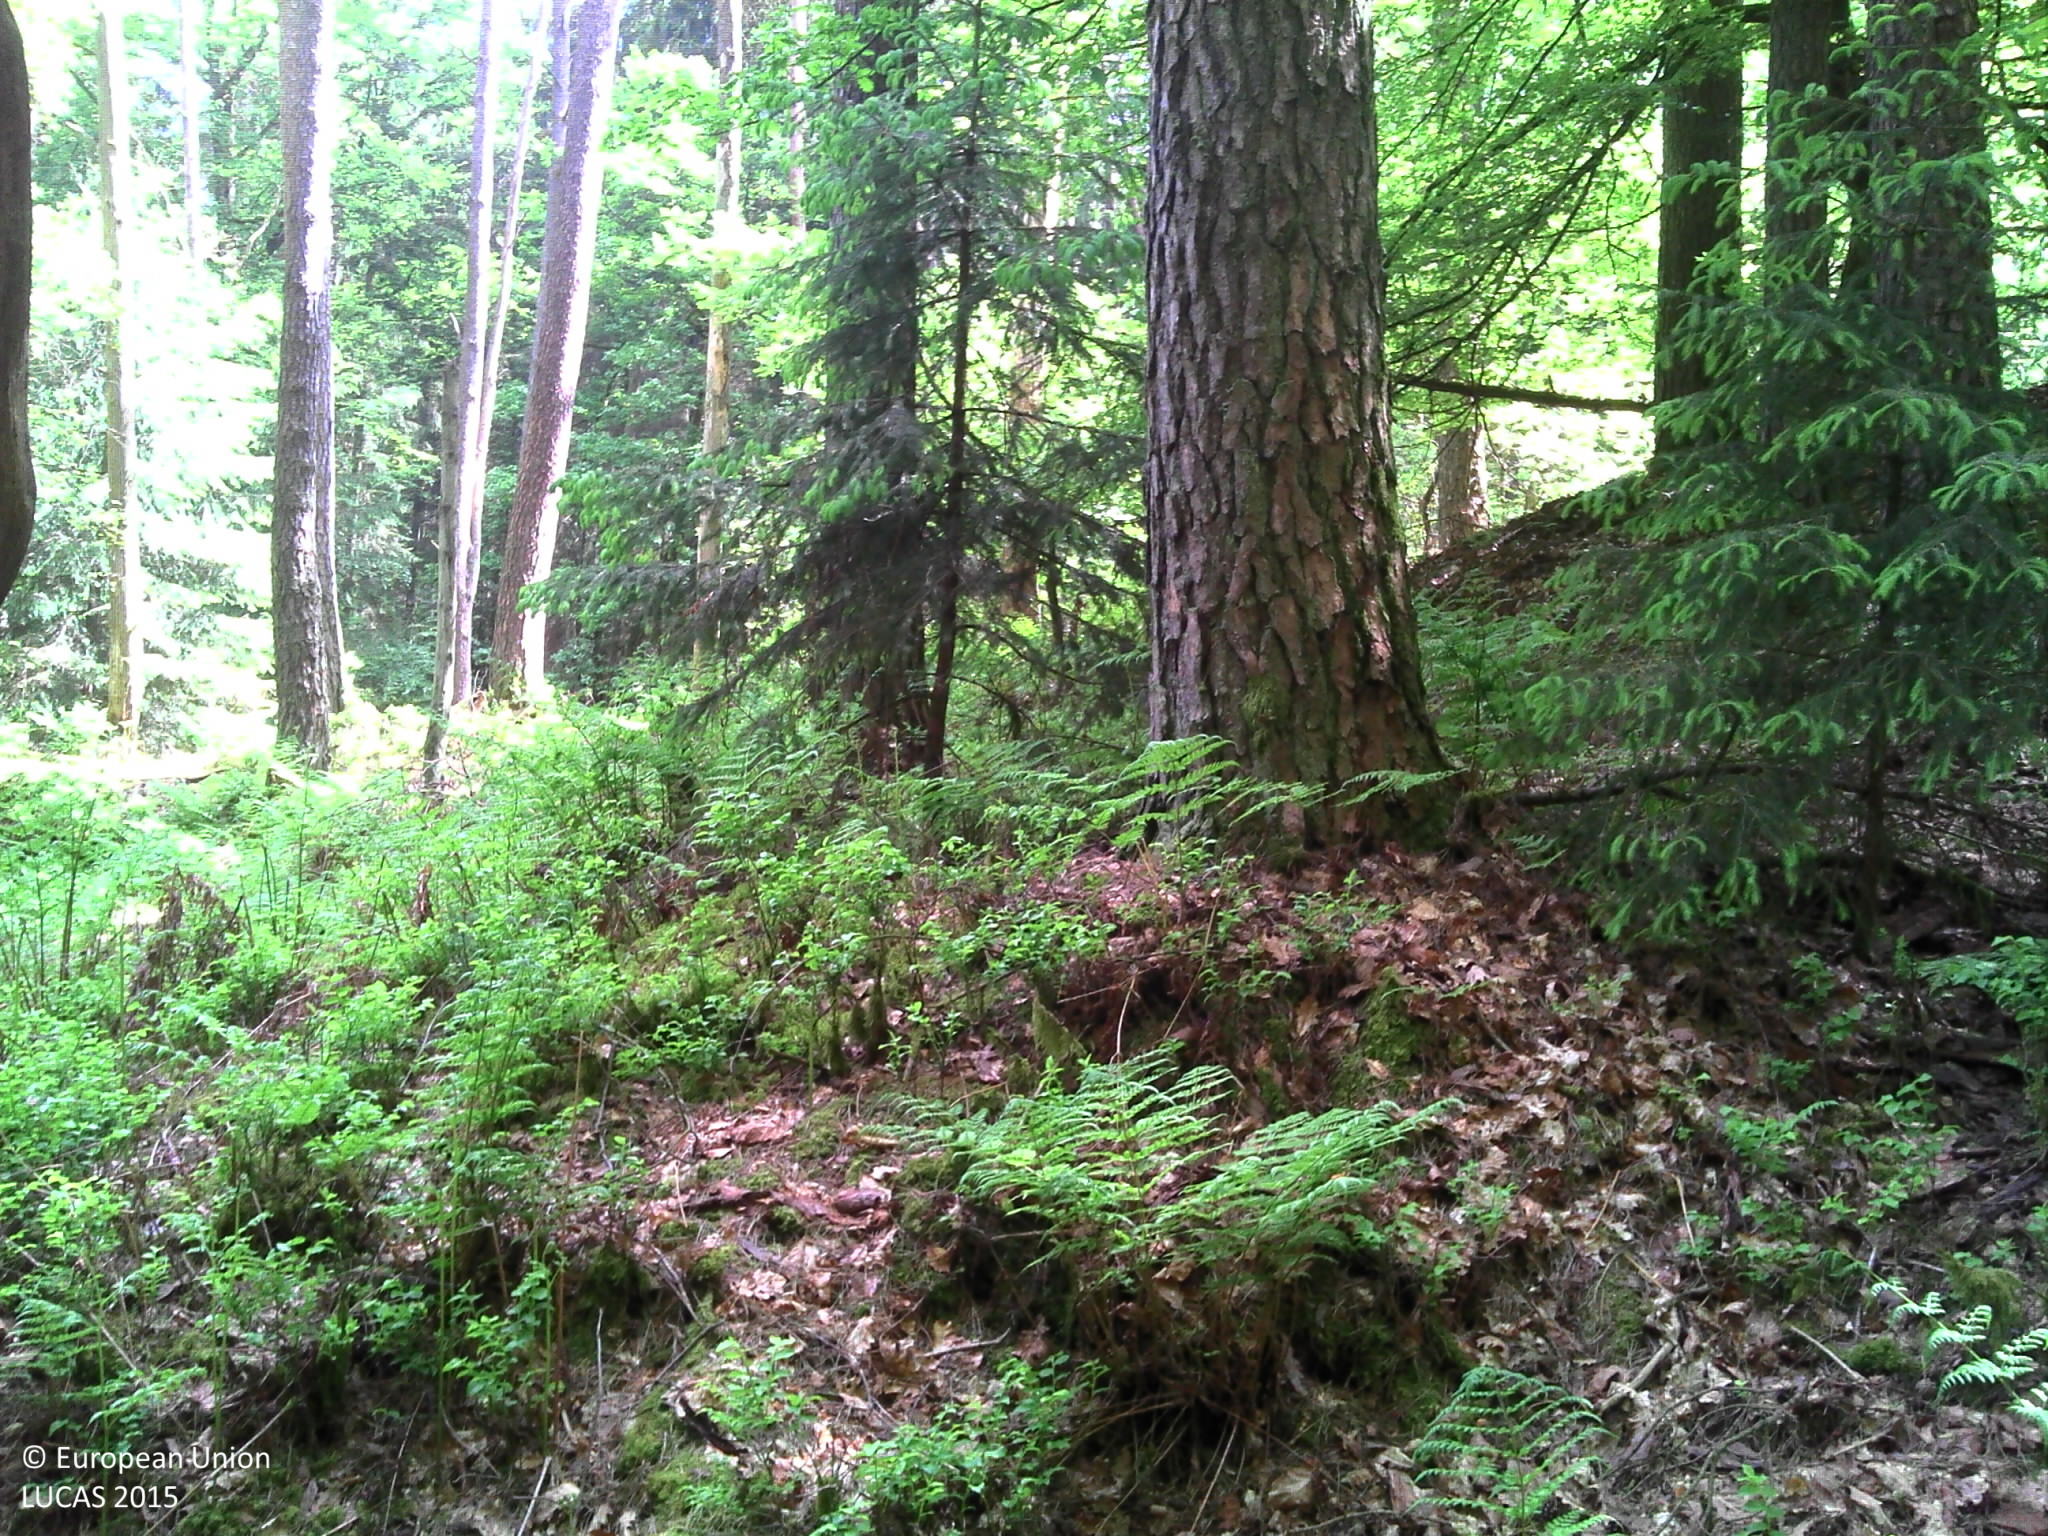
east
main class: Woodland
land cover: Spruce dominated mixed woodland
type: alpine coniferous forest
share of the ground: > 75 %
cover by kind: coniferous forest trees 65 %, broadleaved forest trees 25 %, herbaceous plants 5 %, lichens and mosses 5 %
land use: Forestry
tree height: > 5 m
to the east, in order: Spruce dominated mixed woodland; Tracks; Other coniferous woodland
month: May
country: LU
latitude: 49.7460
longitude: 6.2942
